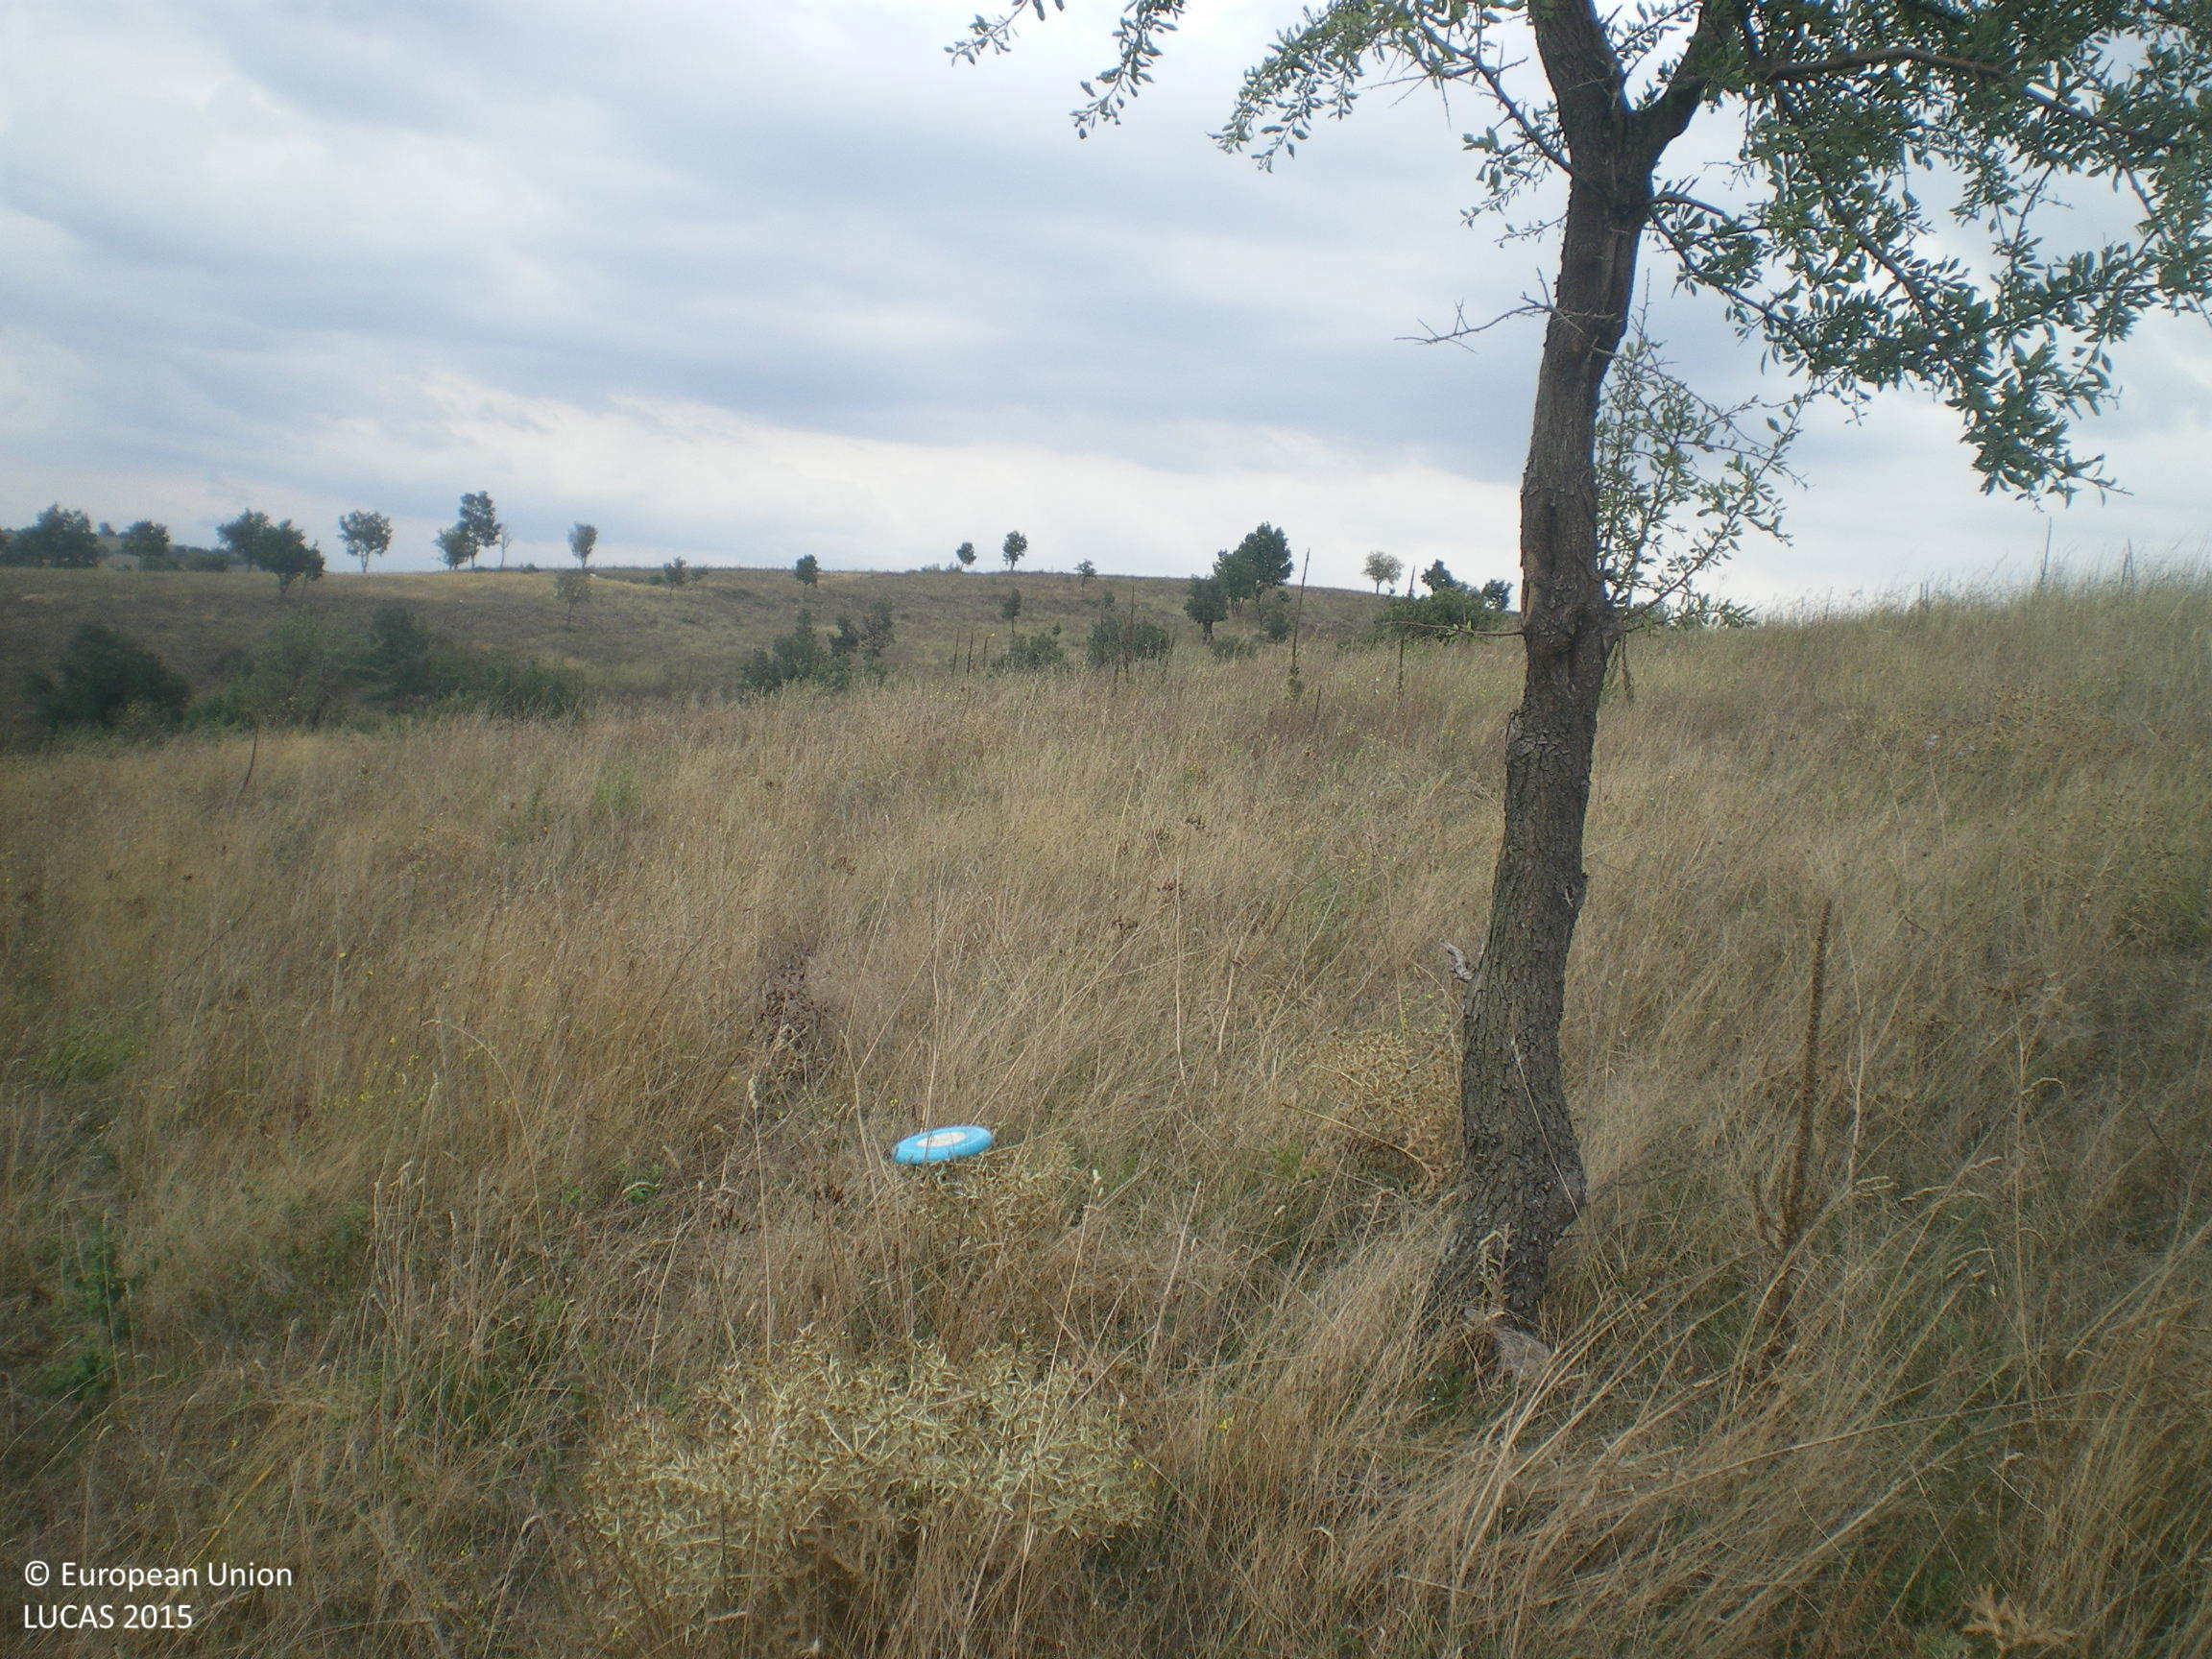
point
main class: Grassland
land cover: Grassland with sparse tree/shrub cover
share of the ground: > 75 %
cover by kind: herbaceous plants 90 %, broadleaved forest trees 5 %, shrubs 5 %
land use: Semi-natural and natural areas not in use
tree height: > 5 m
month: September
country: BG
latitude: 42.0190
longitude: 25.9788
